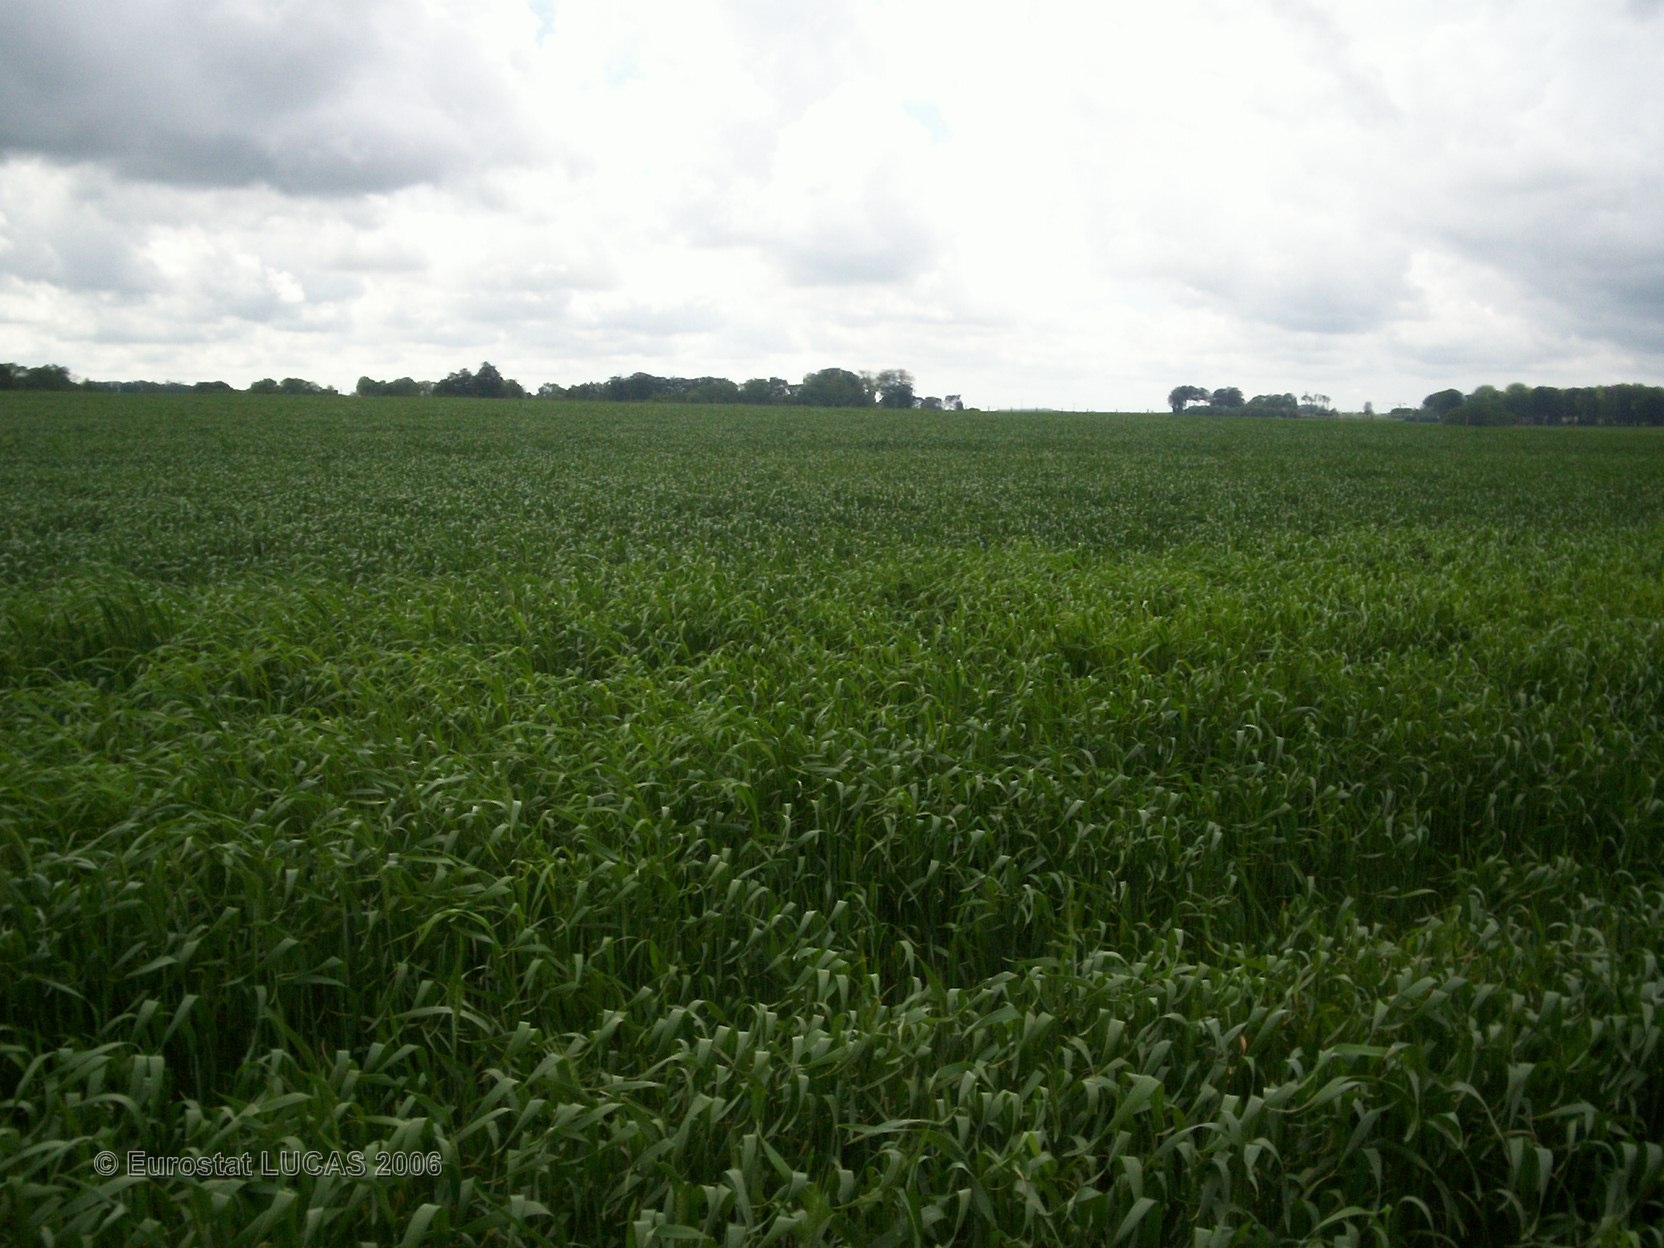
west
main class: Cropland
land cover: Common wheat
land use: Agriculture (excluding fallow land and kitchen gardens)
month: May
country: FR
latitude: 49.6338
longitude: 0.4048
